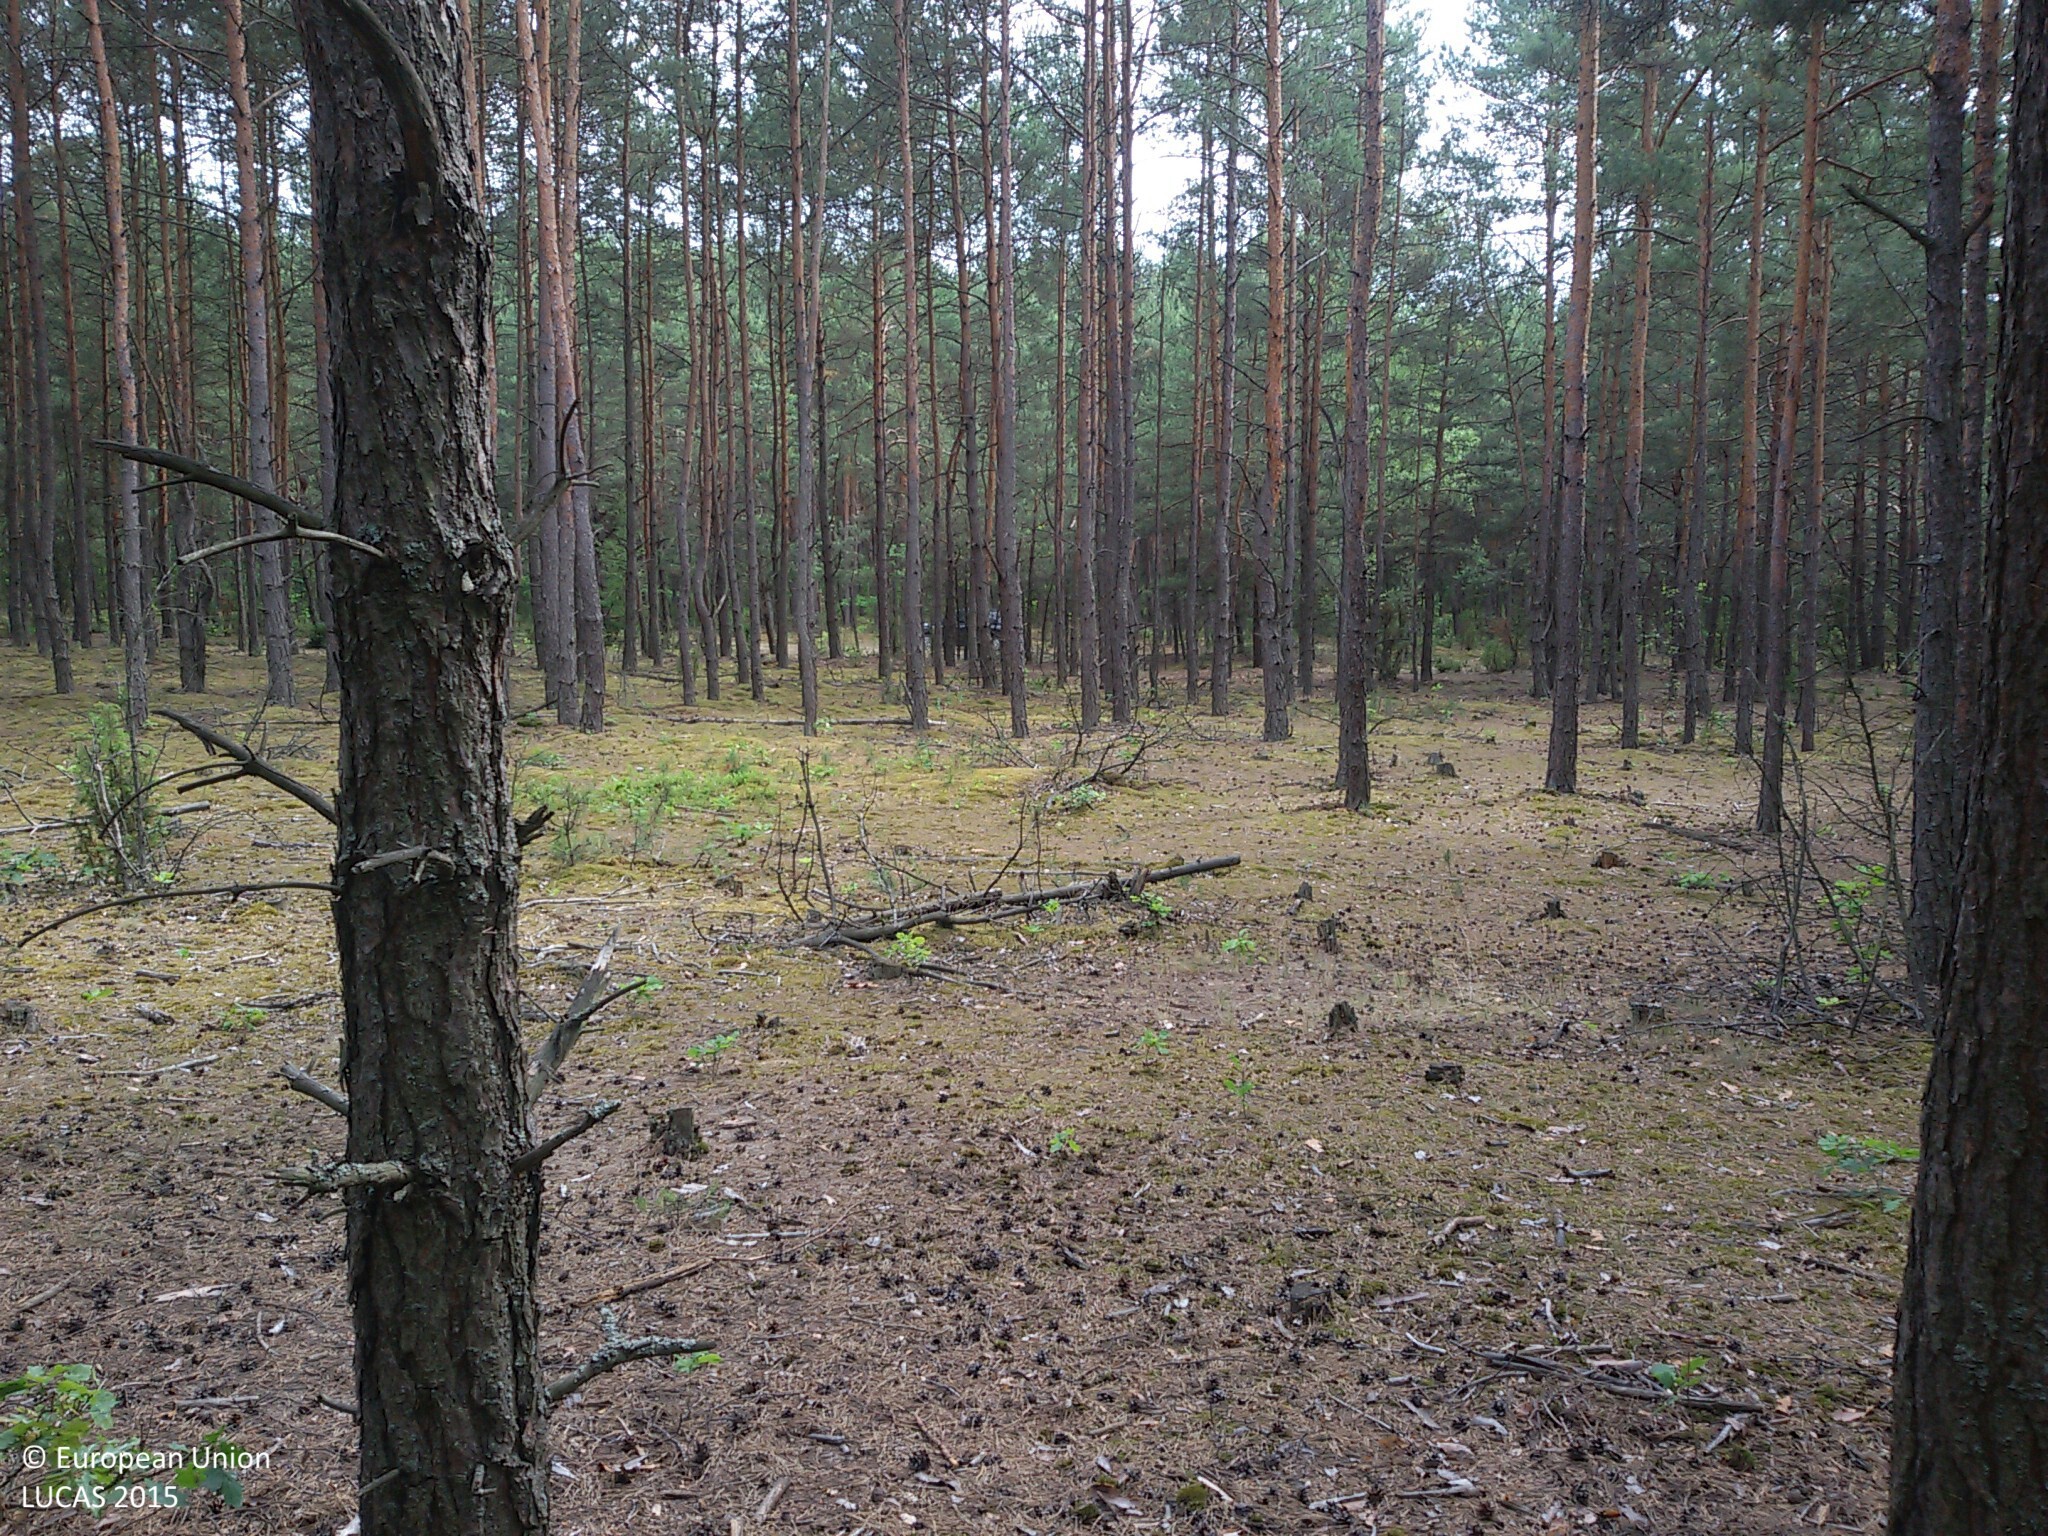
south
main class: Woodland
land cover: Pine dominated coniferous woodland
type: hemiboreal forest and nemoral coniferous forest and mixed broadleaved-coniferous forest
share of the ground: > 75 %
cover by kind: coniferous forest trees 80 %, lichens and mosses 20 %
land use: Forestry
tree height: > 5 m
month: June
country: PL
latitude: 52.2836
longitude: 20.7865
